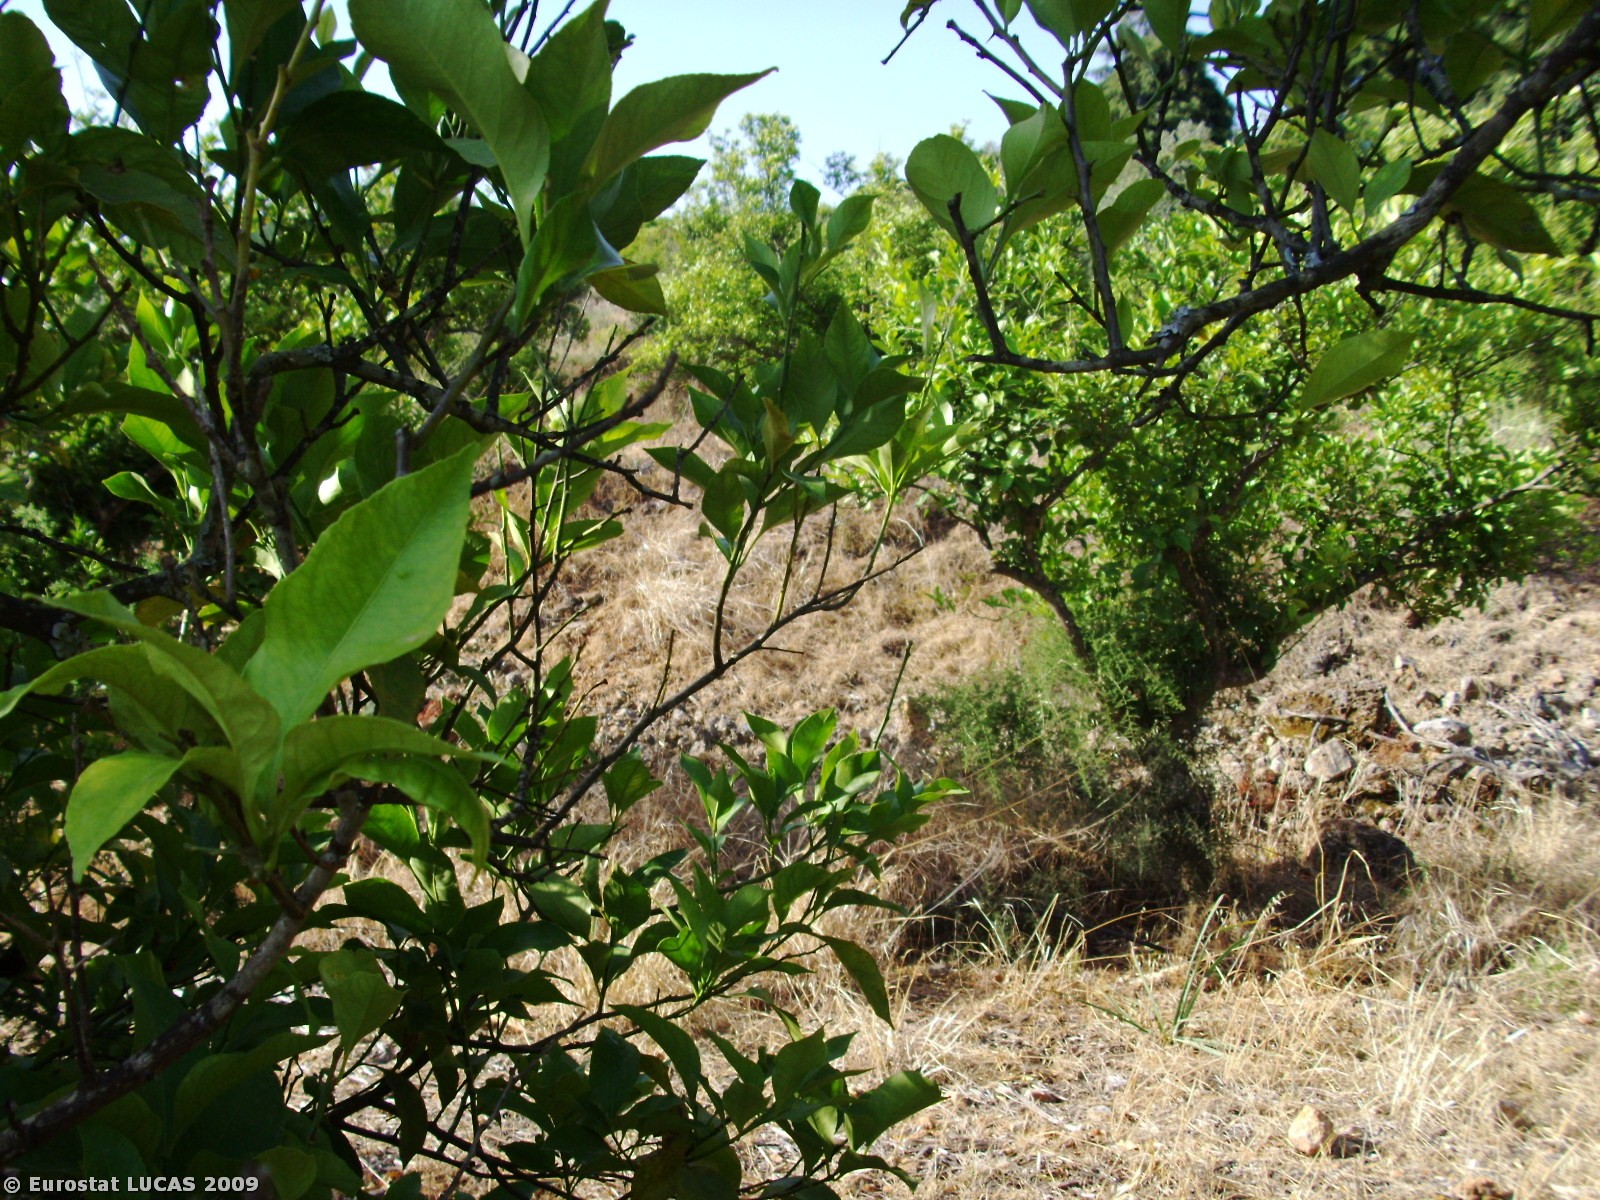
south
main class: Cropland
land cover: Other citrus fruit
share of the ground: 25 - 50 %
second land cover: Spontaneously vegetated surfaces
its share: 50 - 75 %
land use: Agriculture (excluding fallow land and kitchen gardens)
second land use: Fallow land
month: May
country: PT
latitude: 37.1959
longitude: -8.3981
